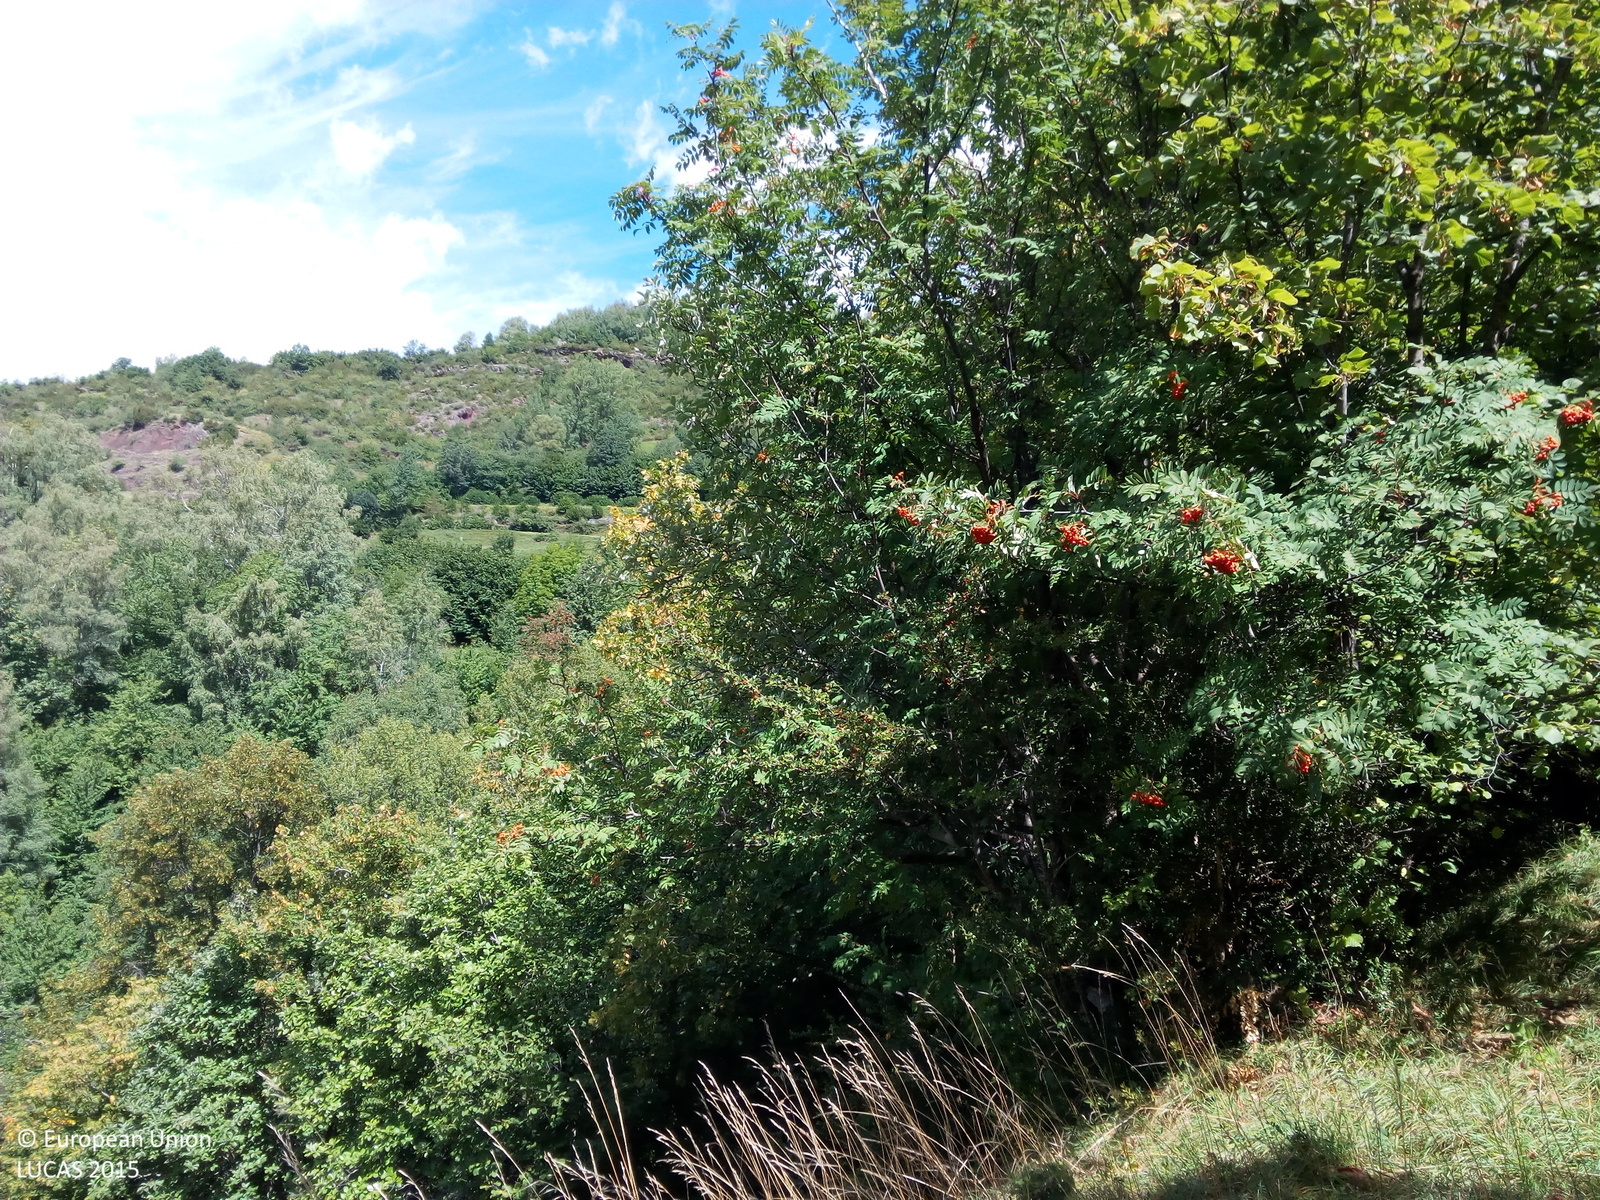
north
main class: Woodland
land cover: Broadleaved woodland
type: floodplain forest
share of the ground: > 75 %
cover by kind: broadleaved forest trees 80 %, herbaceous plants 15 %, shrubs 5 %
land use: Semi-natural and natural areas not in use
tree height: > 5 m
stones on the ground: < 10 %
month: September
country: ES
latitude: 42.5755
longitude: 0.3665
